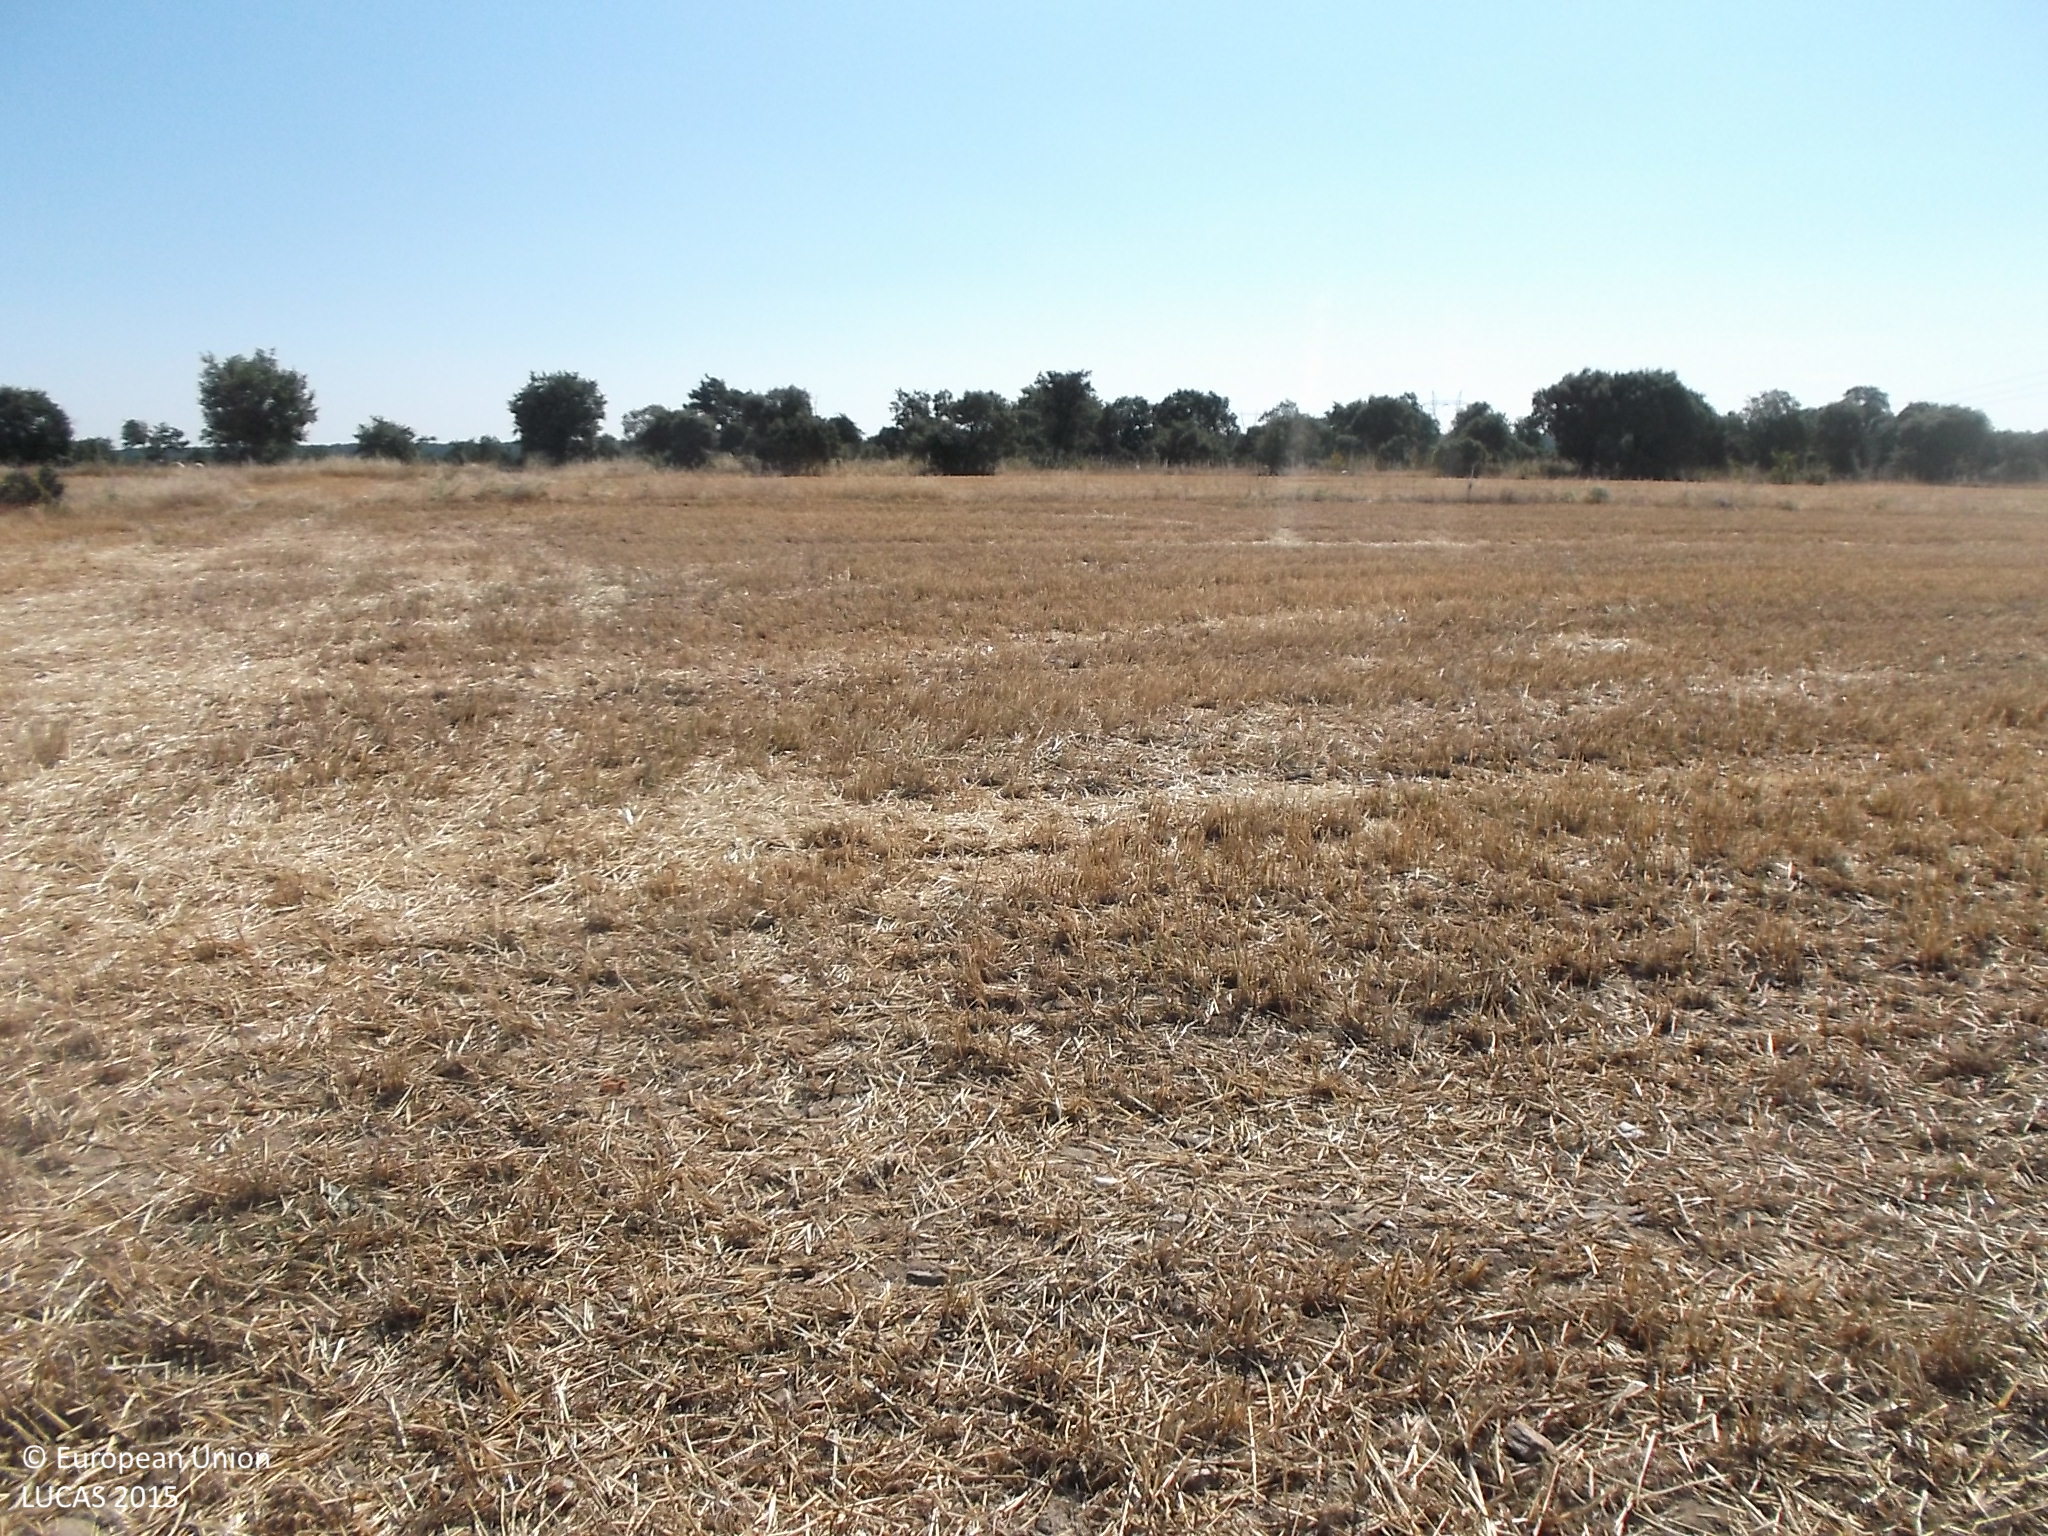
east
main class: Cropland
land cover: Barley
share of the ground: < 10 %
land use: Agriculture (excluding fallow land and kitchen gardens)
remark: Harvested field
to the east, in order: Barley; Grass margins; Barley; Broadleaved woodland; Oats; Grass margins; Oats; Grass margins; Oats; Grassland with sparse tree/shrub cover
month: July
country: ES
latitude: 41.3681
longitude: -6.0267
